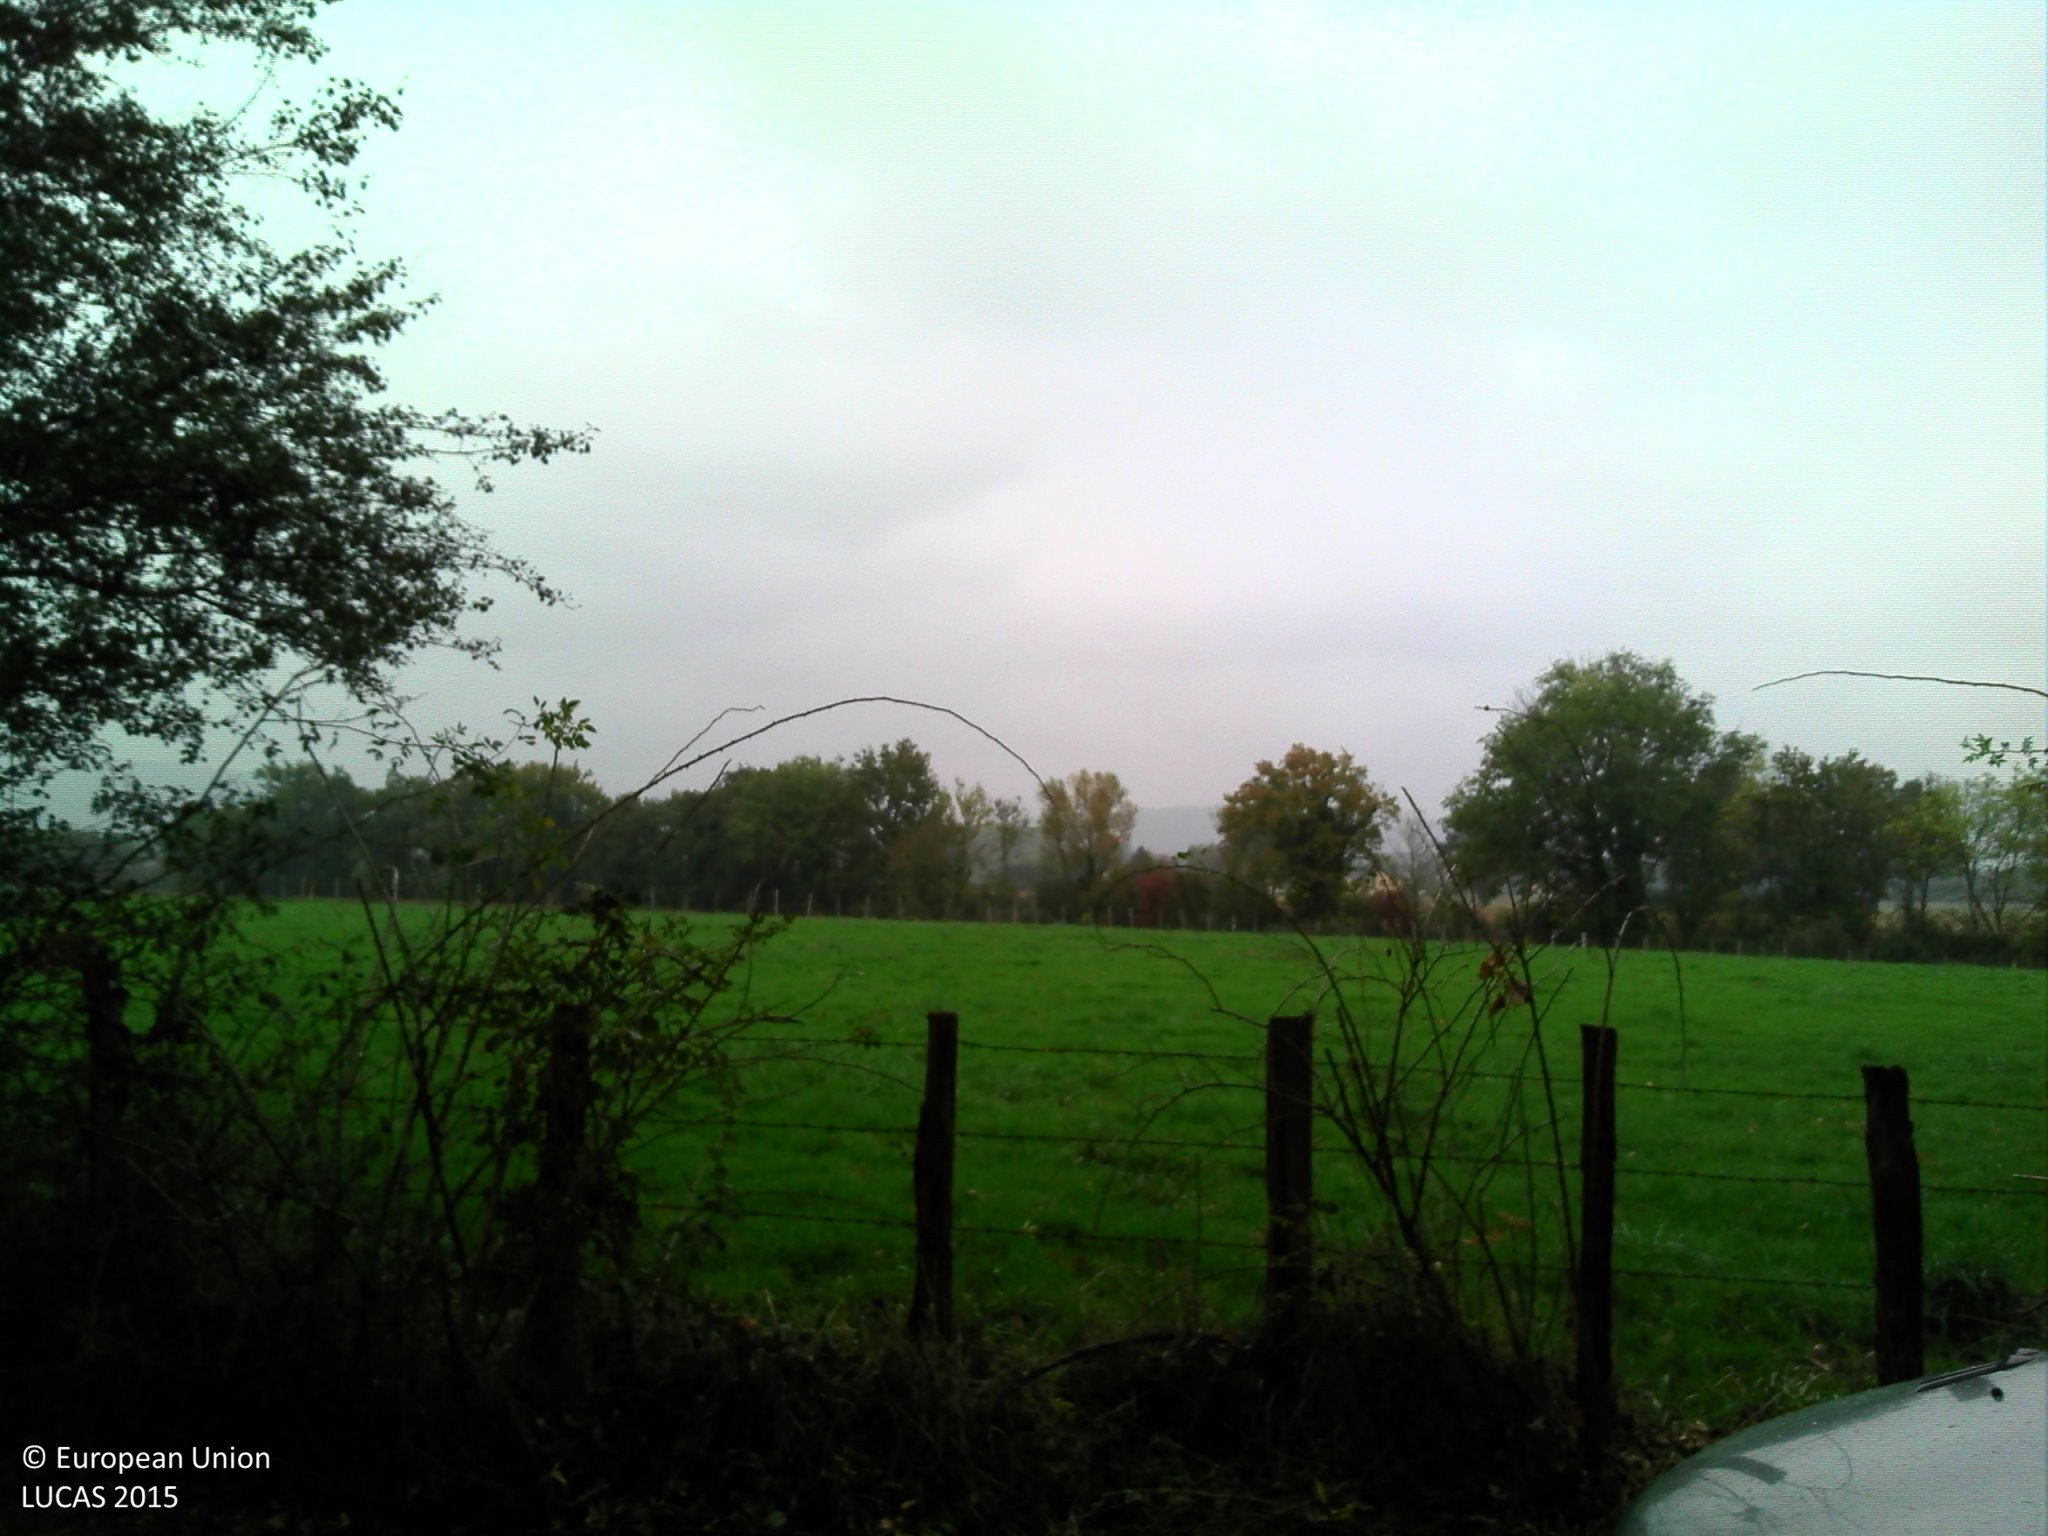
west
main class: Grassland
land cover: Grassland without tree/shrub cover
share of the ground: > 75 %
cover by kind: herbaceous plants 100 %
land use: Agriculture (excluding fallow land and kitchen gardens)
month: October
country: FR
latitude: 46.1567
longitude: 5.2767
